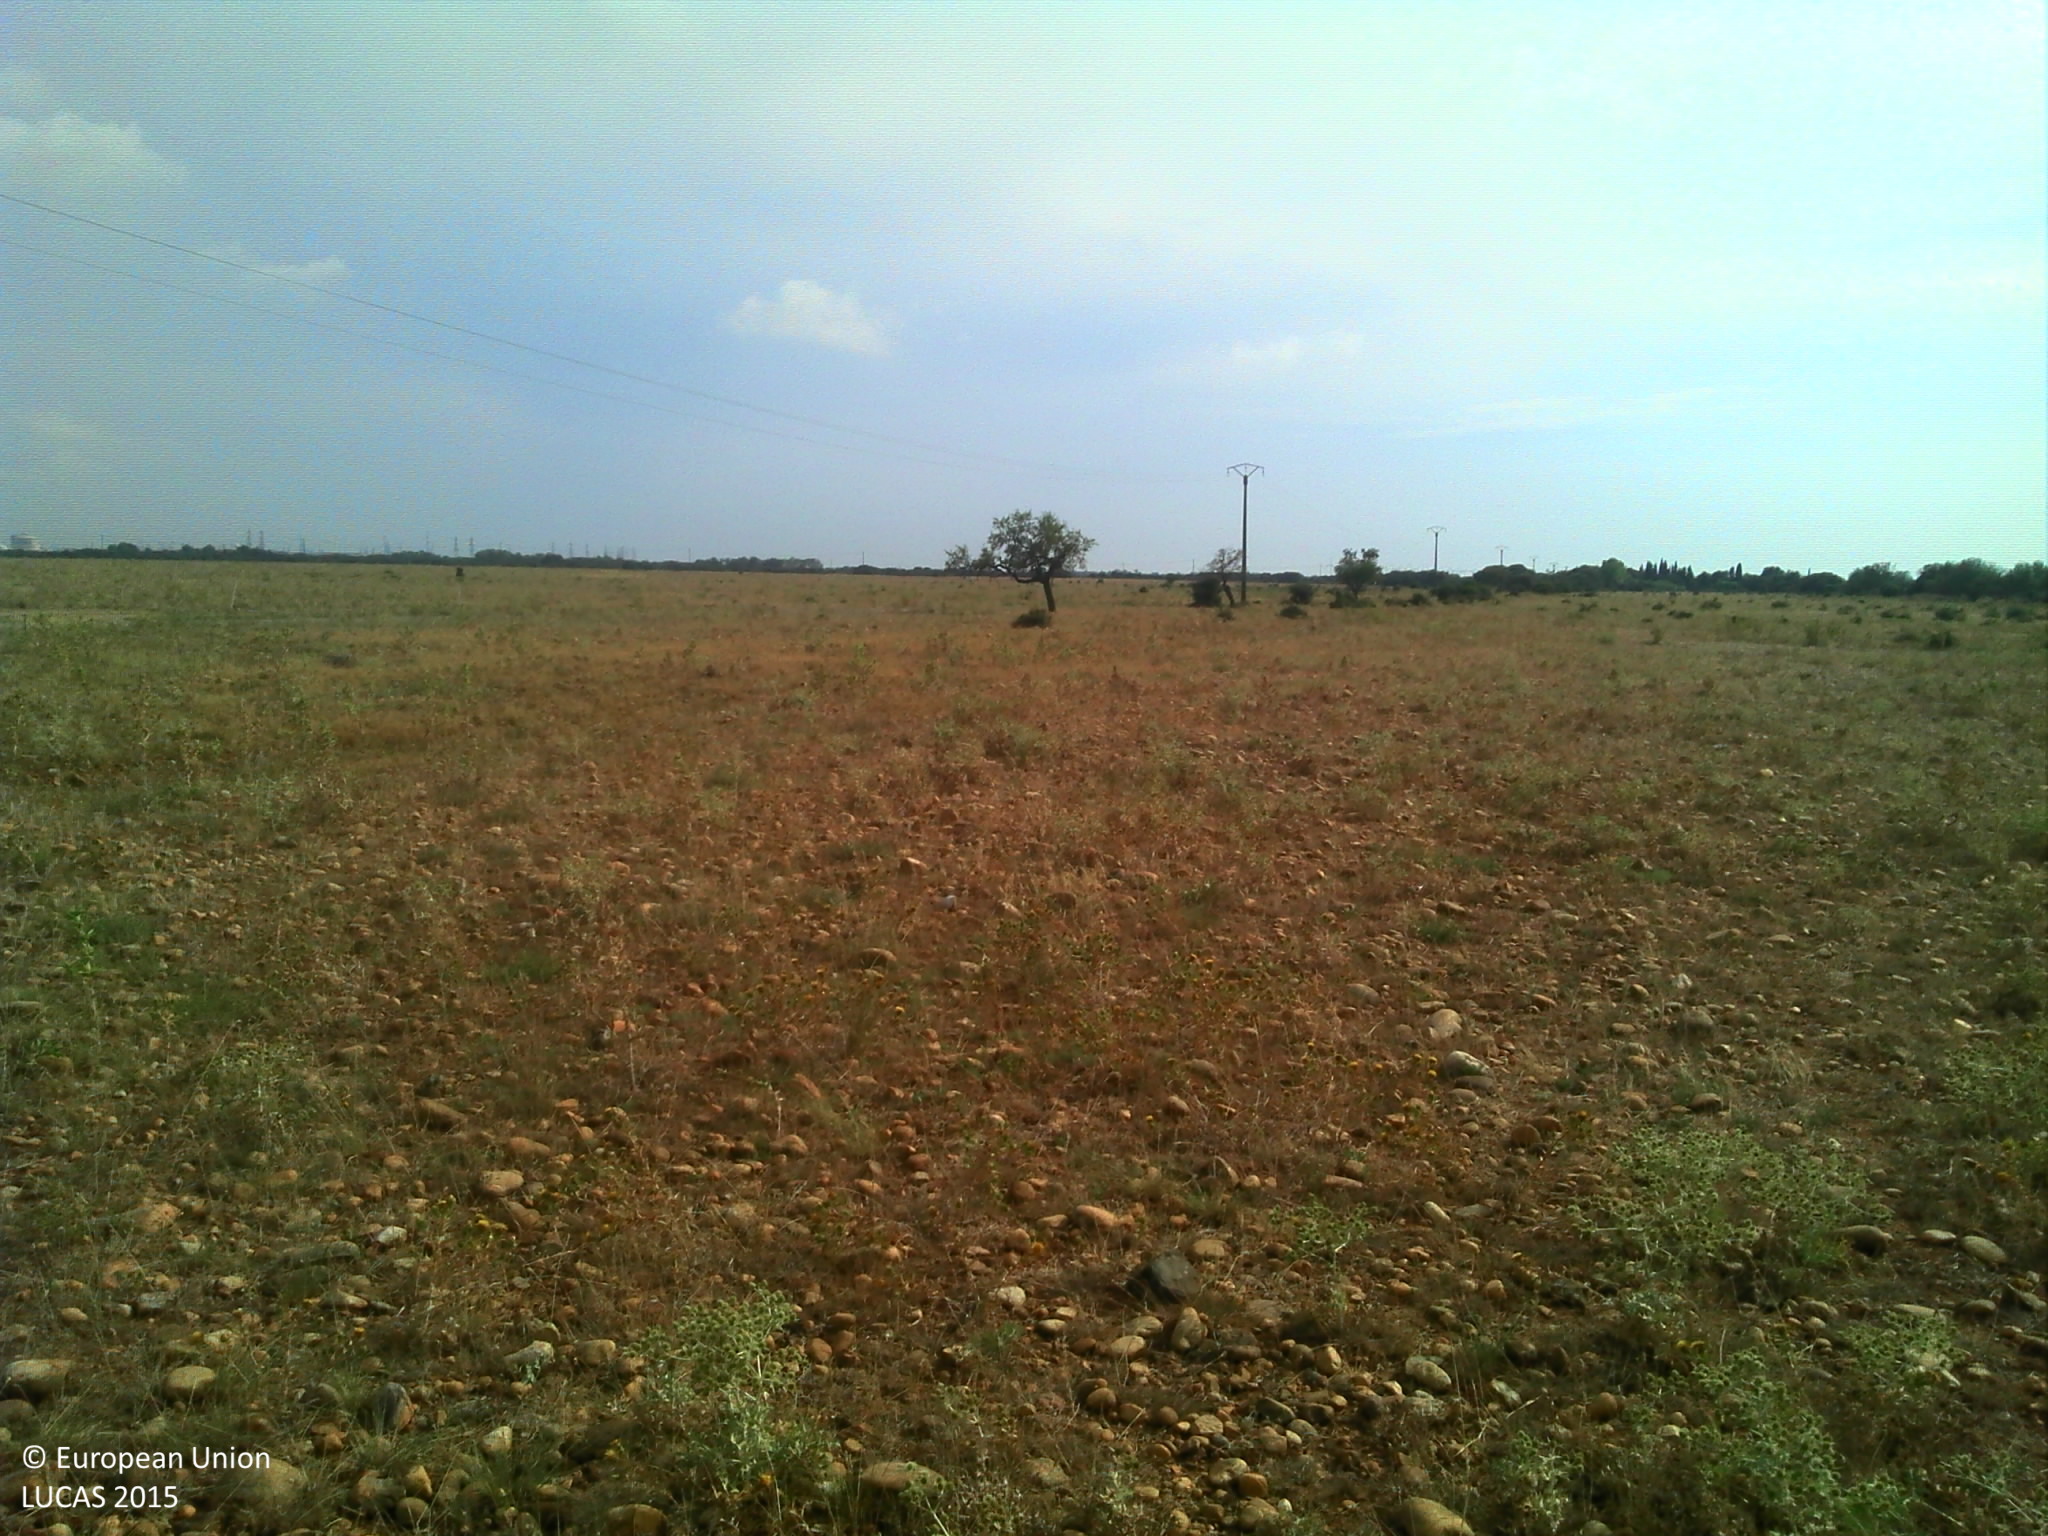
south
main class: Grassland
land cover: Spontaneously vegetated surfaces
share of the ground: 25 - 50 %
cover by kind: unconsolidated bare surface 60 %, herbaceous plants 35 %, shrubs 5 %
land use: Agriculture (excluding fallow land and kitchen gardens)
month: July
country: FR
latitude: 43.4998
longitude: 4.8528
